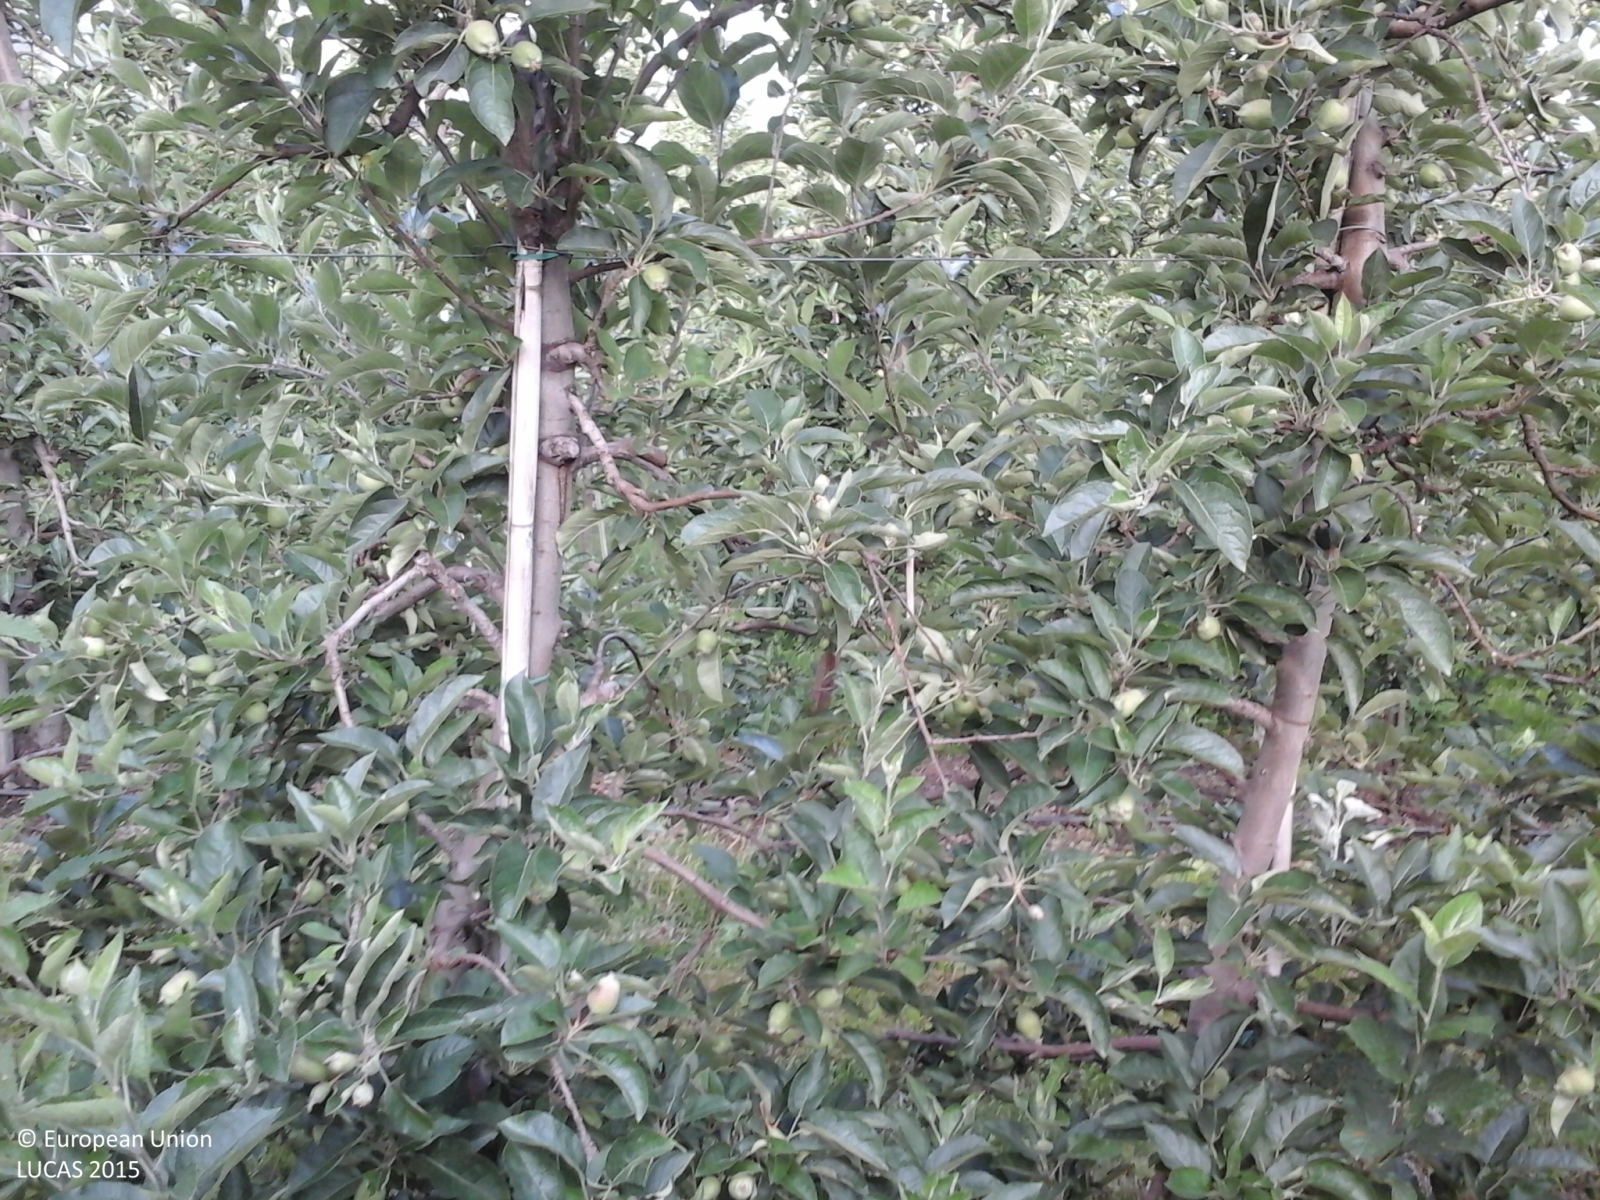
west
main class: Cropland
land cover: Apple fruit
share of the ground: > 75 %
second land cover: Grassland without tree/shrub cover
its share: > 75 %
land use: Agriculture (excluding fallow land and kitchen gardens)
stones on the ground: < 10 %
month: June
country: IT
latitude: 46.6349
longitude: 10.9785
